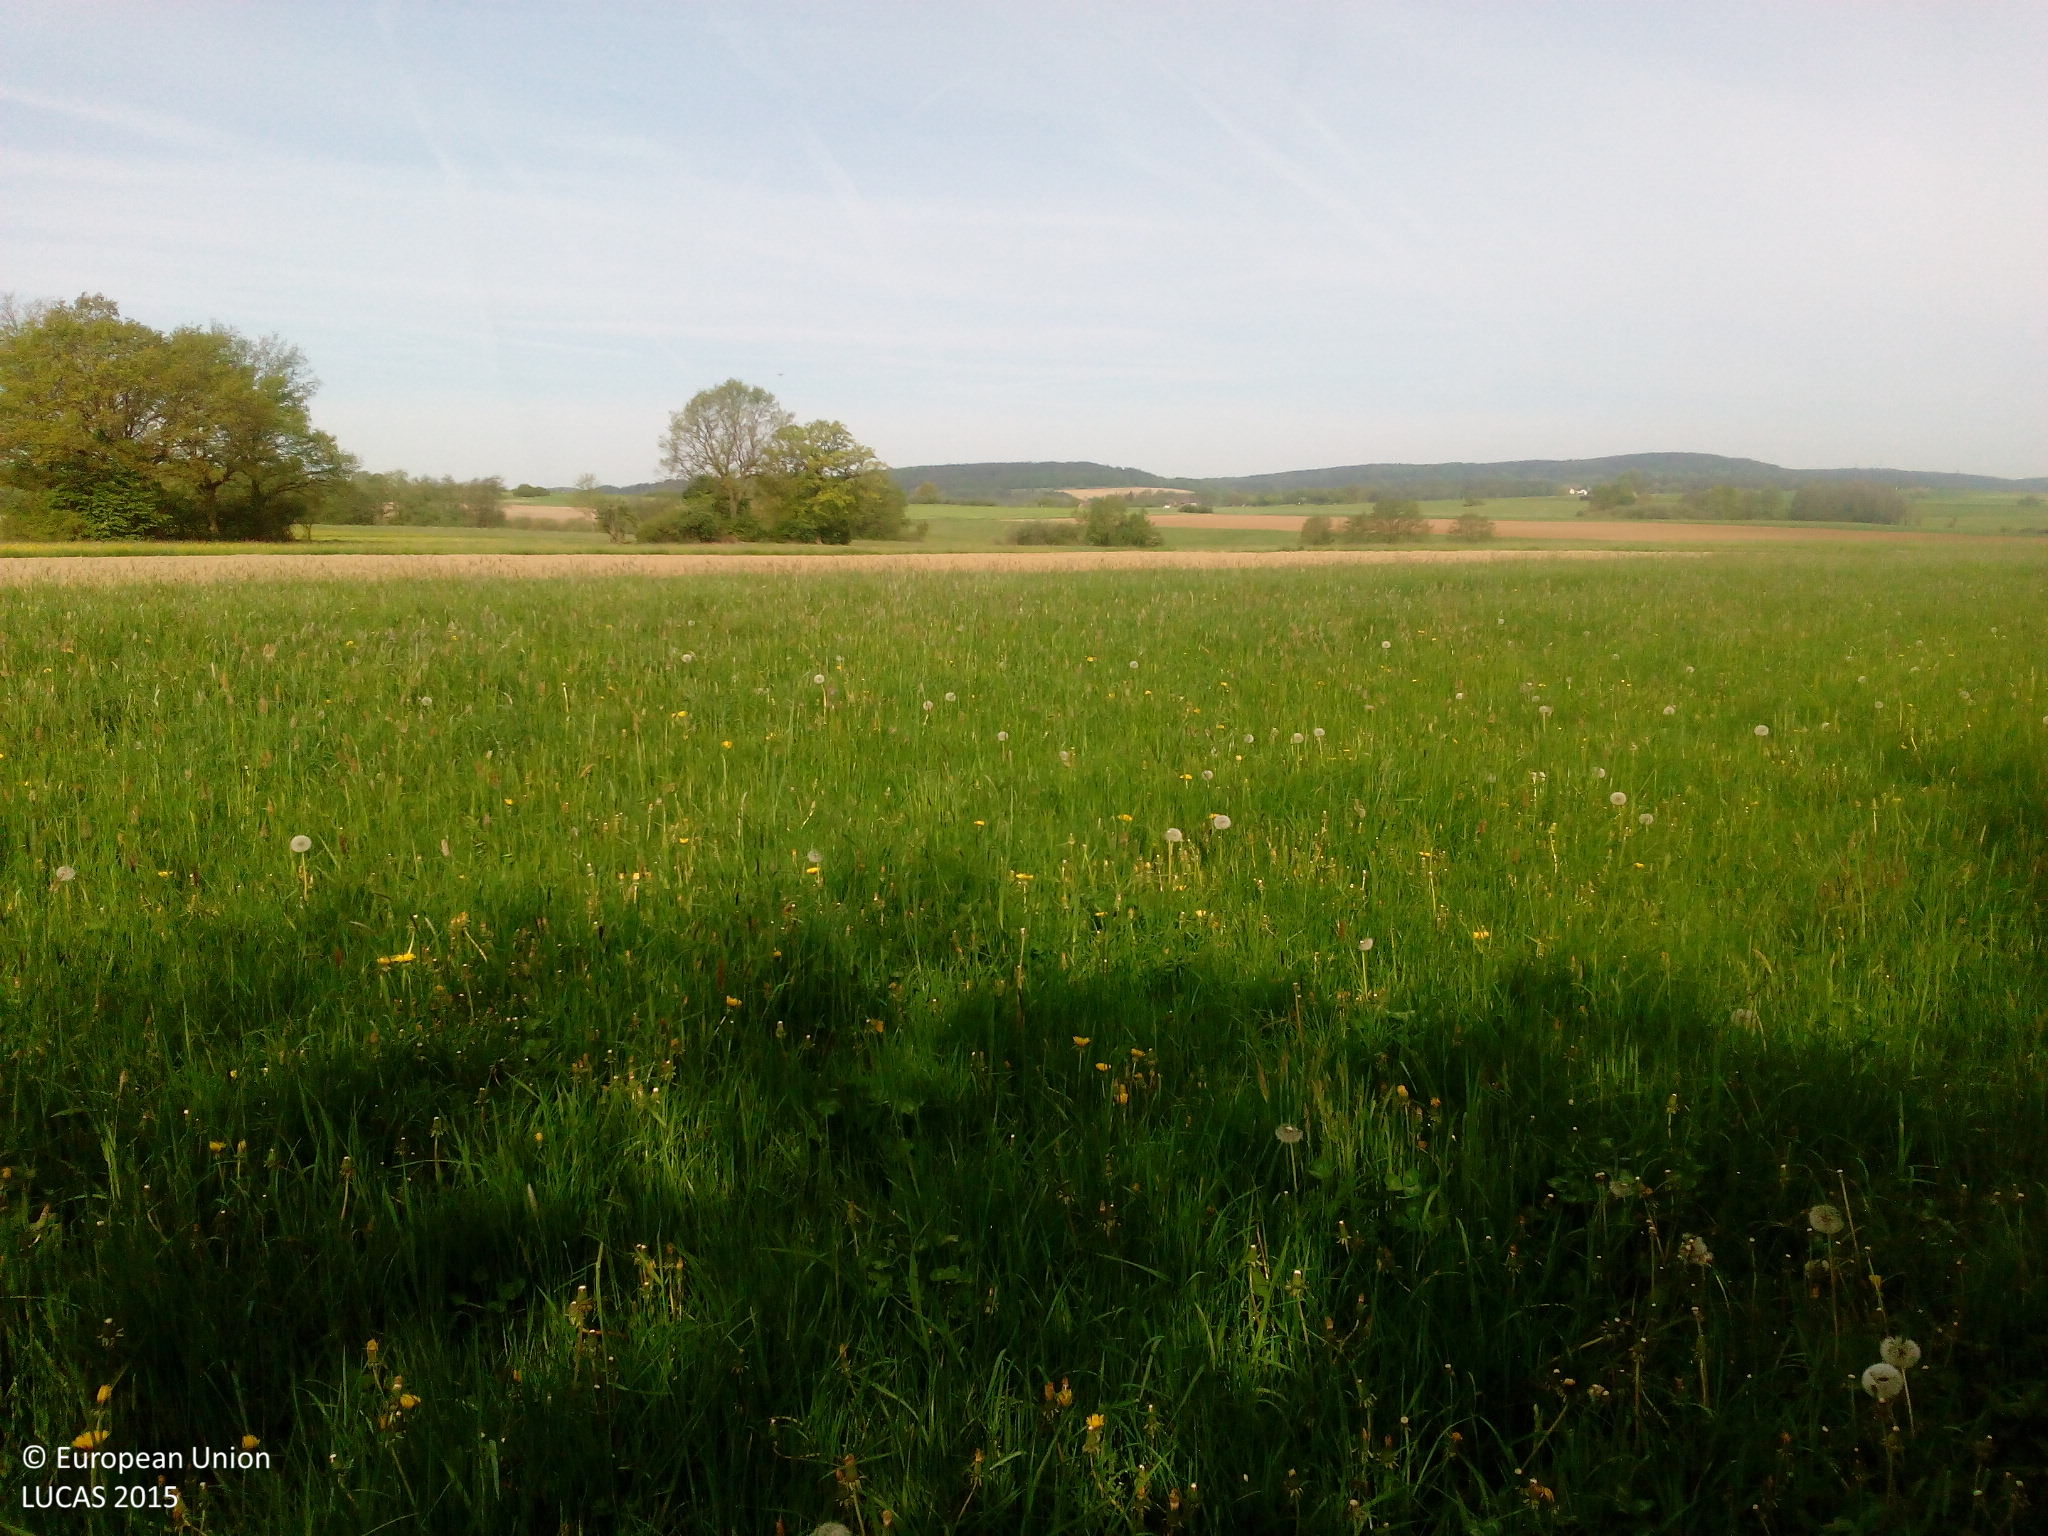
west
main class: Shrubland
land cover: Shrubland with sparse tree cover
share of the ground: > 75 %
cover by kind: shrubs 95 %, broadleaved forest trees 5 %
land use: Semi-natural and natural areas not in use
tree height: < 5 m
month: May
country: DE
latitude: 49.9227
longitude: 11.4900
